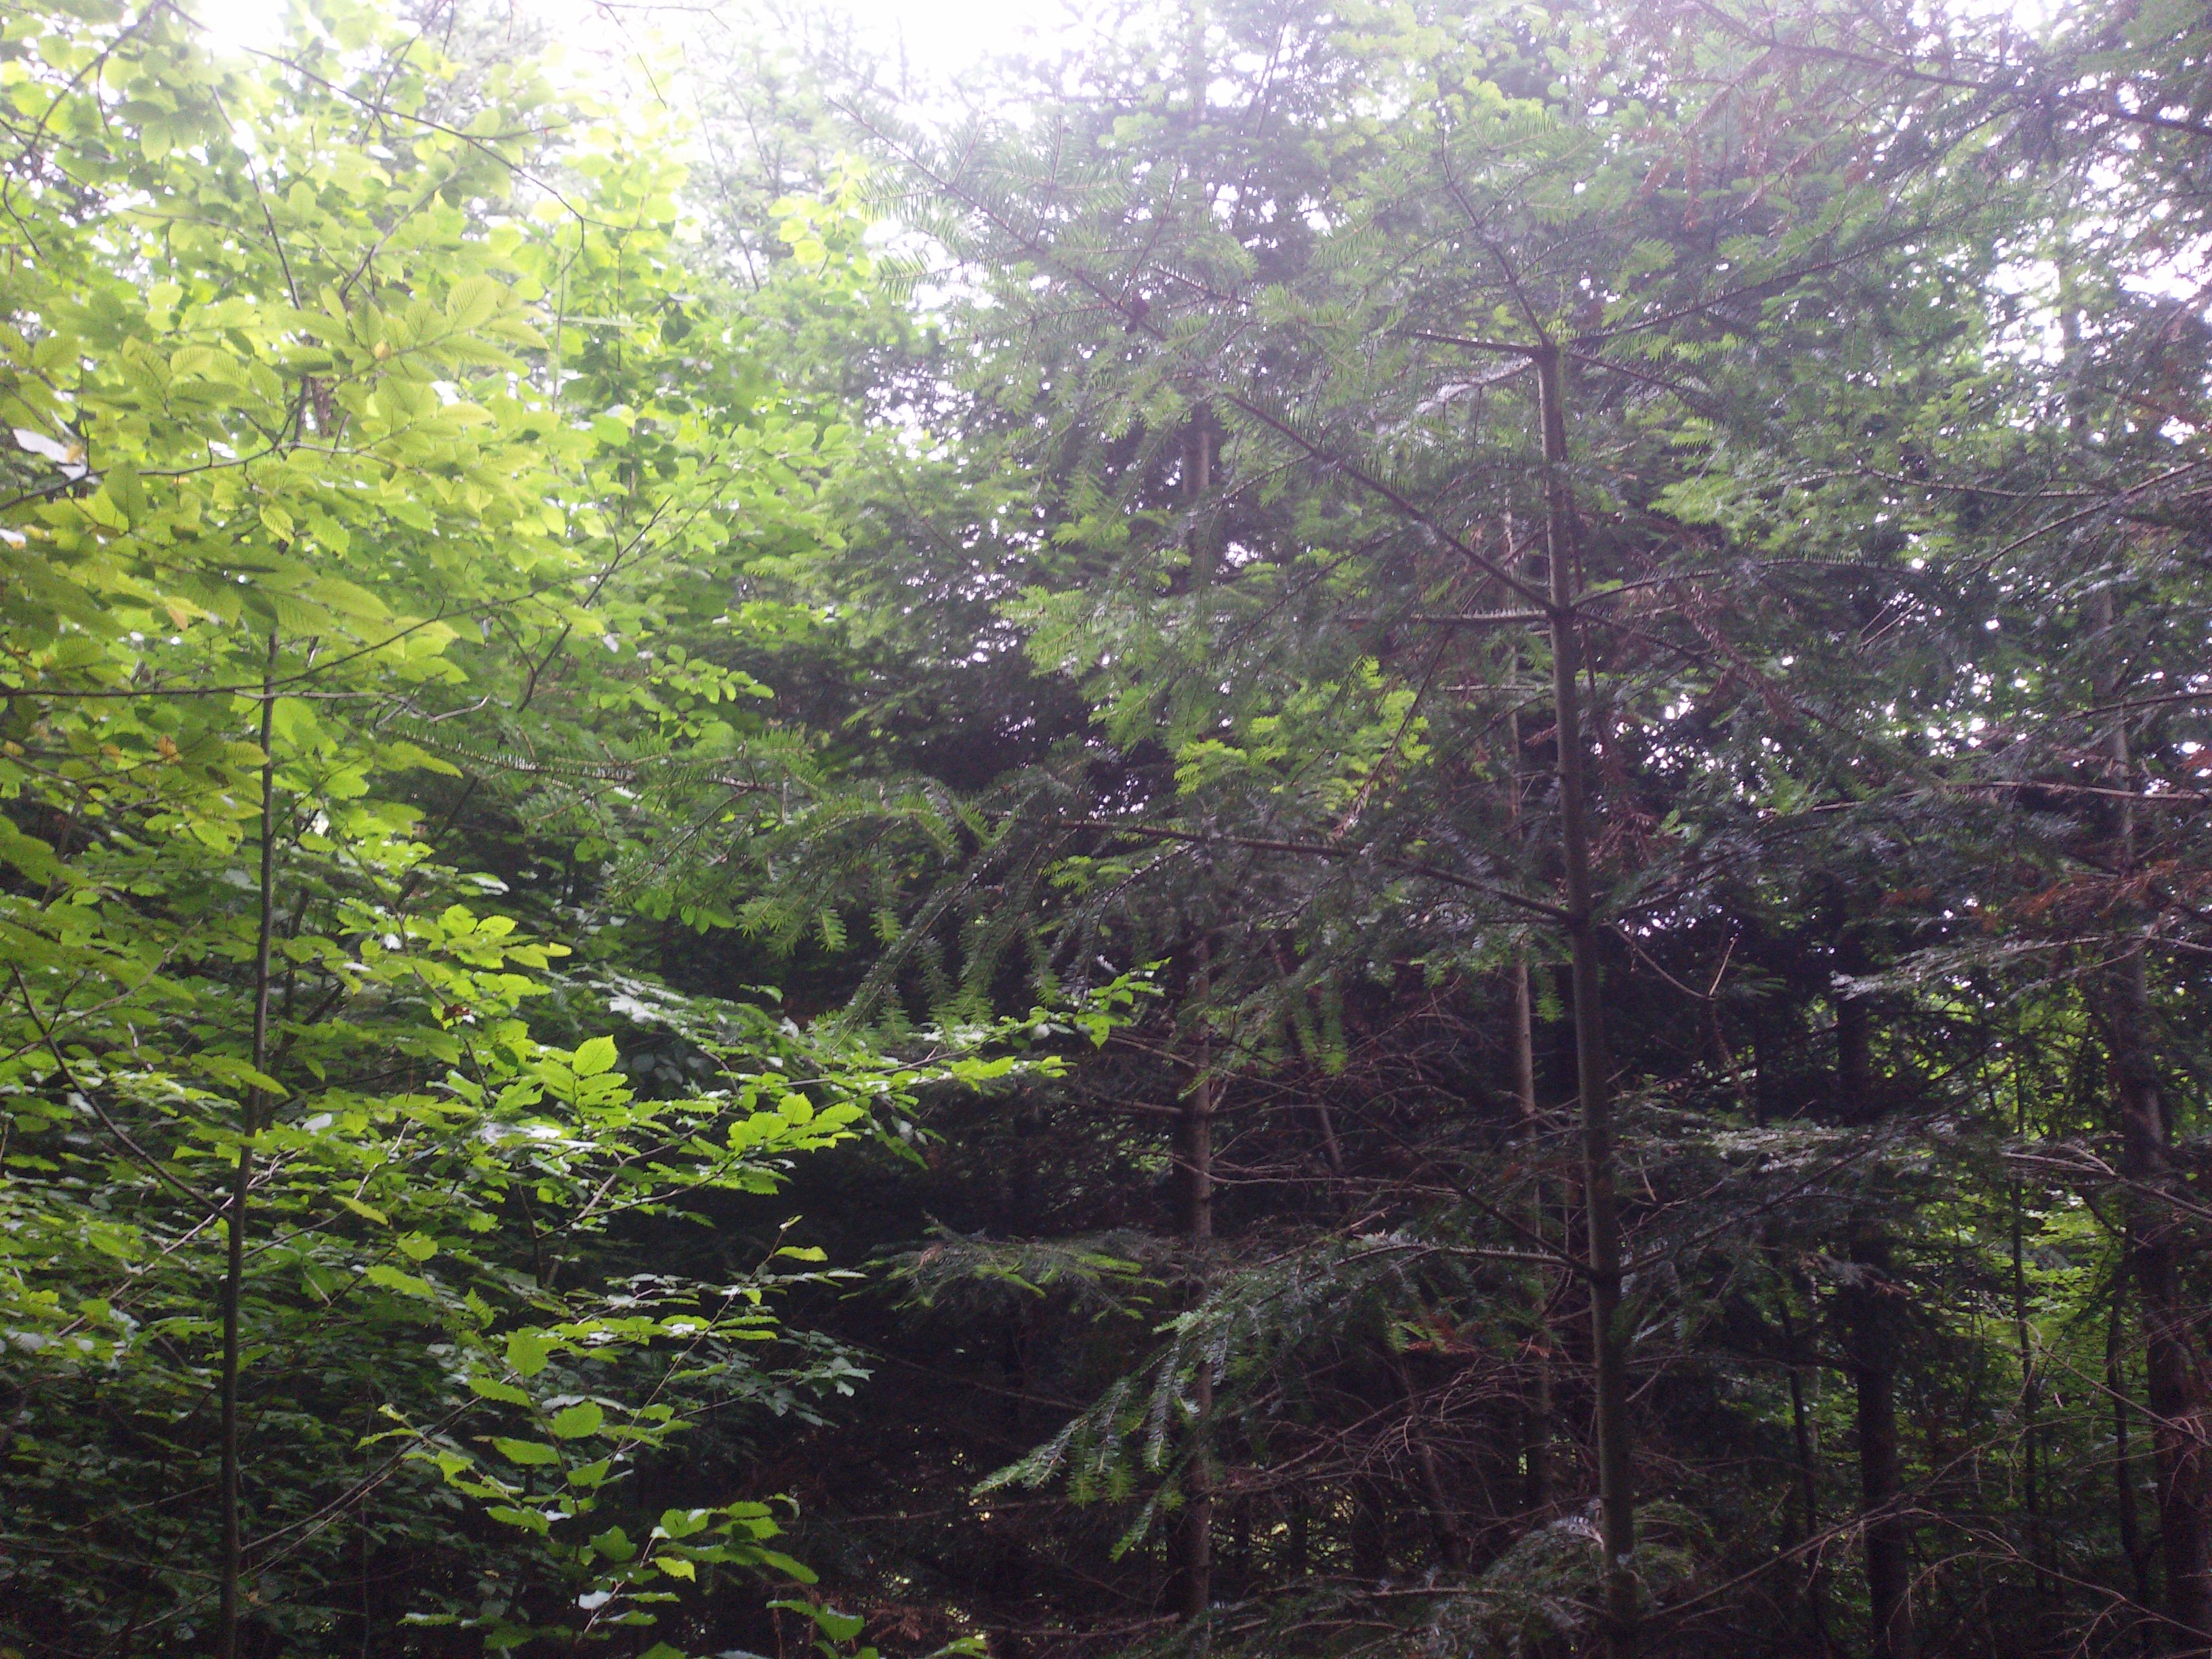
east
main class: Woodland
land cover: Other mixed woodland
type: hemiboreal forest and nemoral coniferous forest and mixed broadleaved-coniferous forest
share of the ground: > 75 %
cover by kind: broadleaved forest trees 50 %, coniferous forest trees 30 %, unconsolidated bare surface 10 %, shrubs 5 %, herbaceous plants 5 %
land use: Forestry
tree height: > 5 m
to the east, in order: Other mixed woodland; Spontaneously vegetated surfaces; Tracks; Fences; Spontaneously vegetated surfaces; Other coniferous woodland; Broadleaved woodland
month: July
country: PL
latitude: 49.7381
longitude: 22.2576
